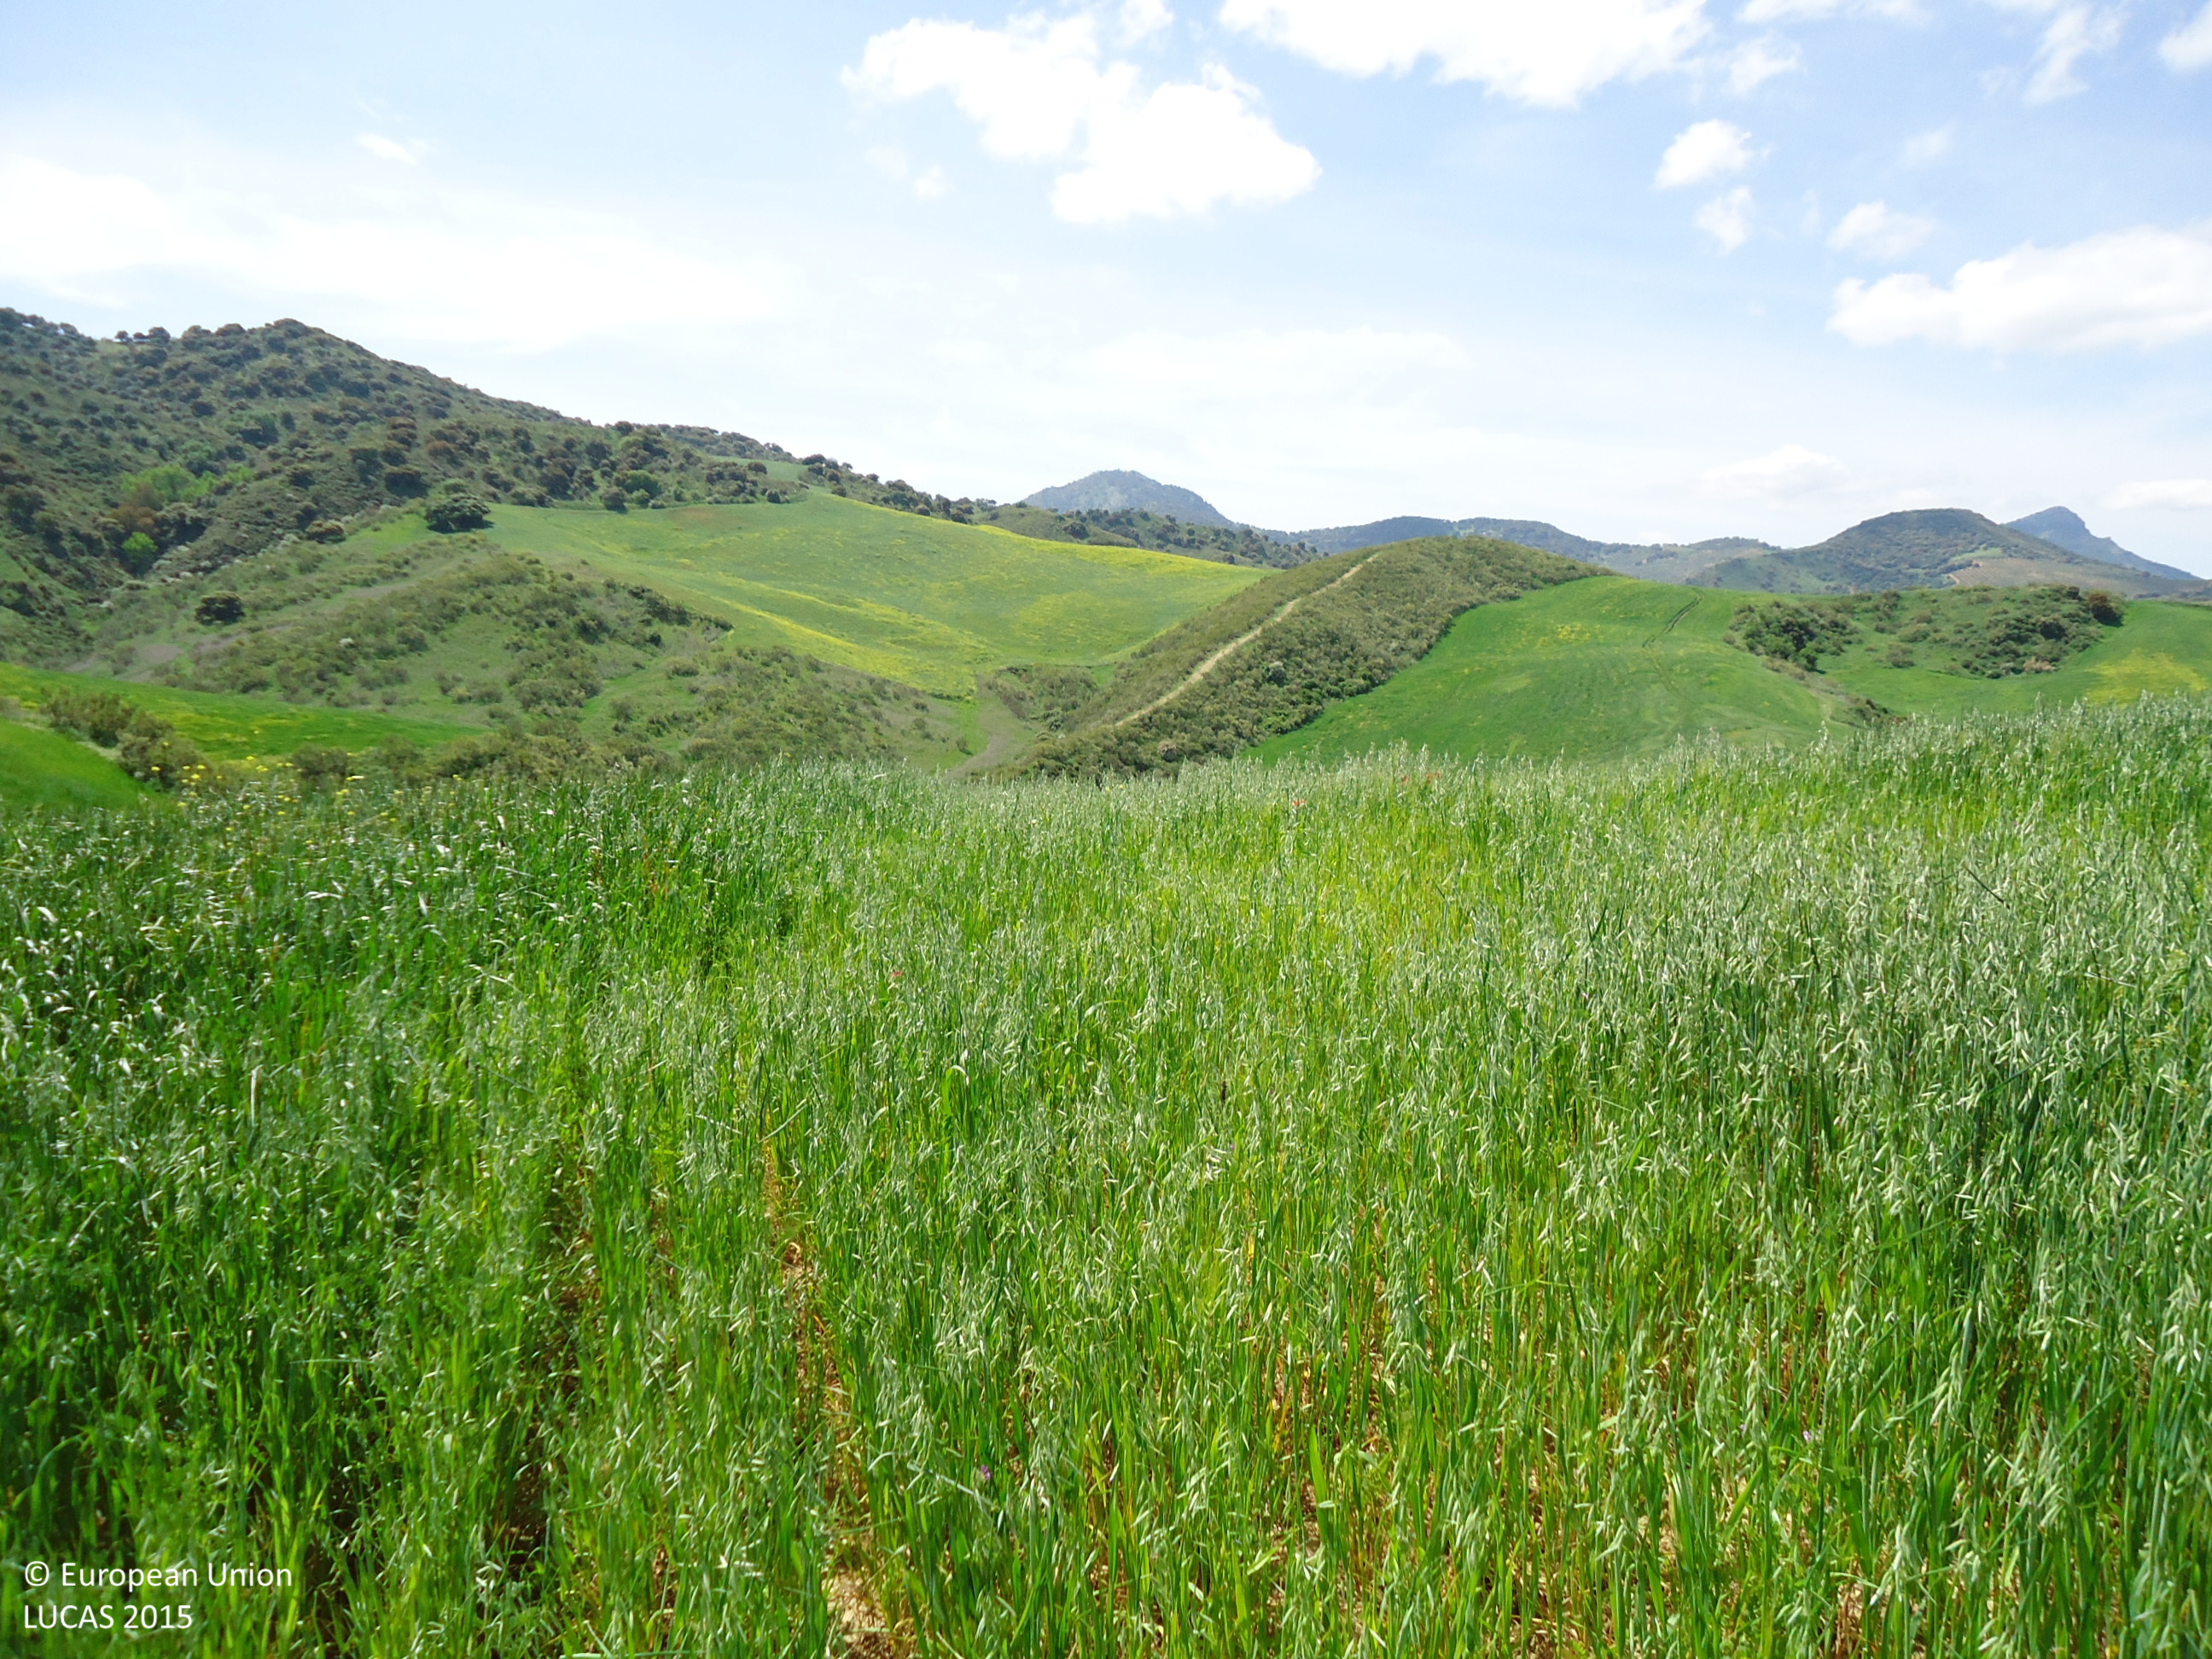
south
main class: Cropland
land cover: Oats
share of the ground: > 75 %
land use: Agriculture (excluding fallow land and kitchen gardens)
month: April
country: ES
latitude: 36.8923
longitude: -5.2756
